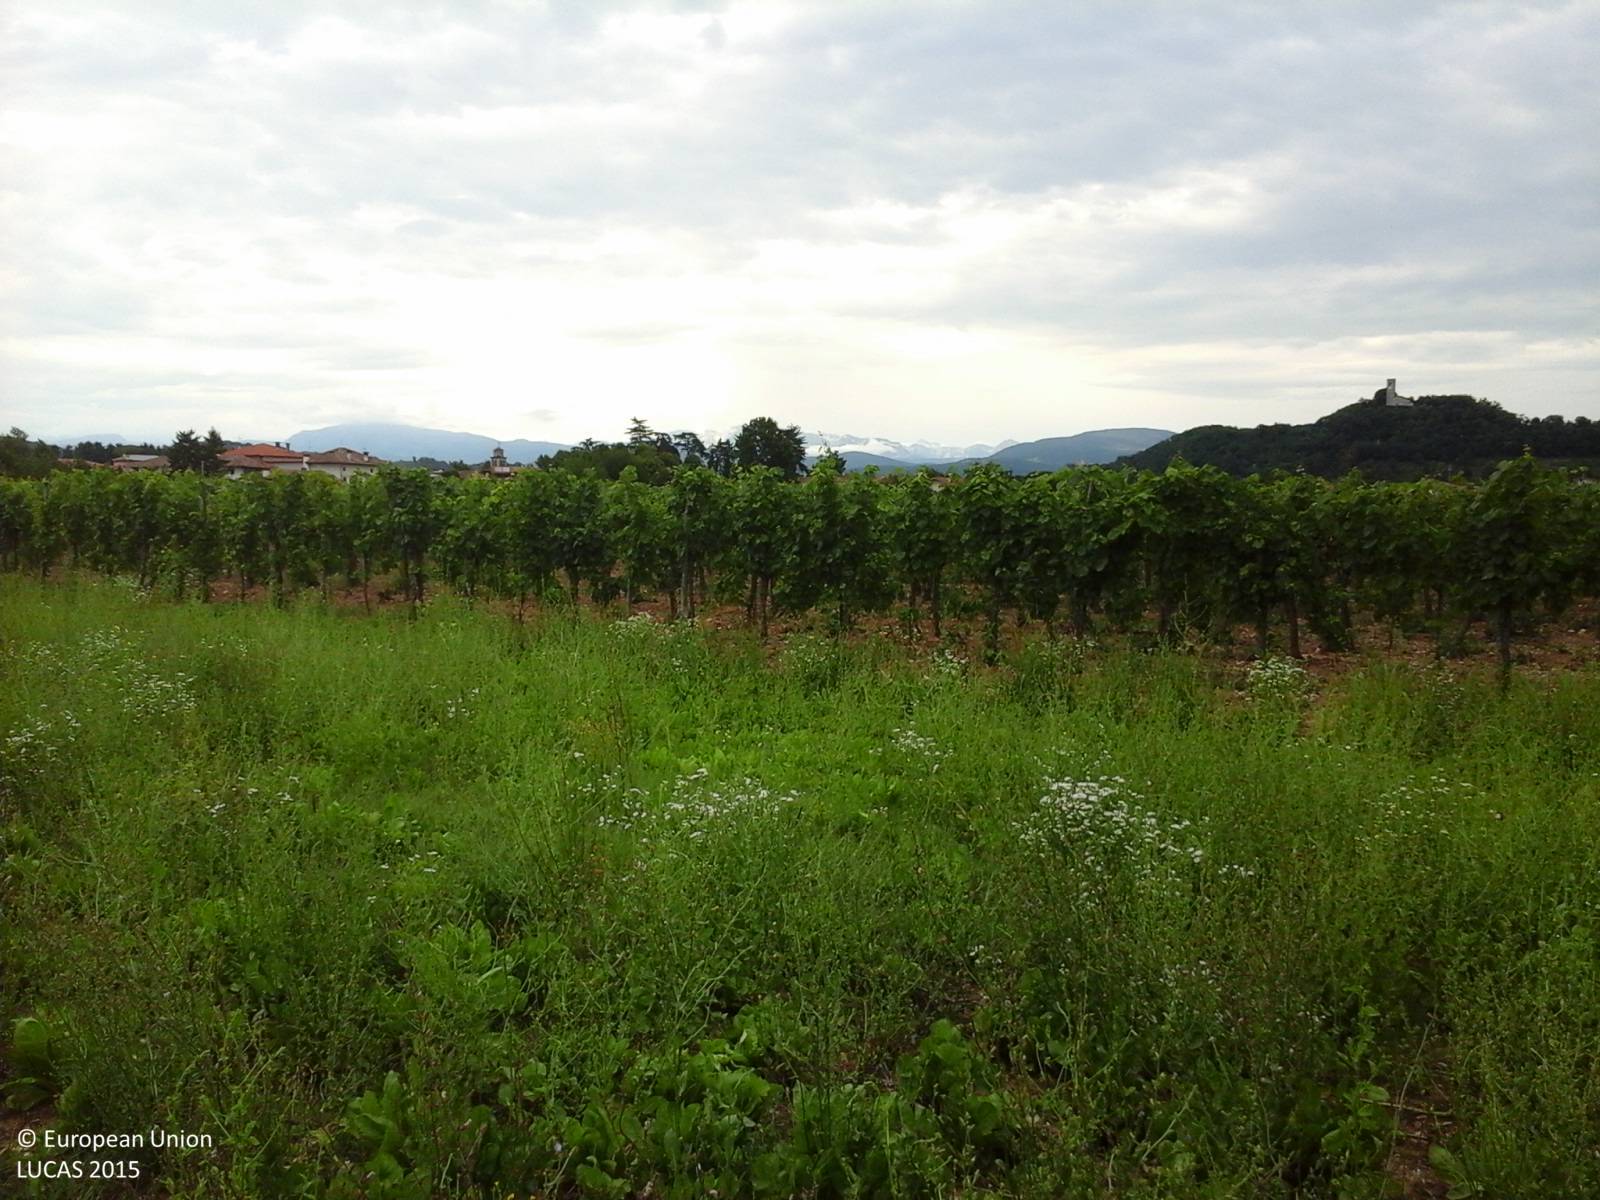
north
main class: Grassland
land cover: Spontaneously vegetated surfaces
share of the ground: > 75 %
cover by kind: herbaceous plants 100 %
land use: Fallow land
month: June
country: IT
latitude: 45.9713
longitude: 13.4420
